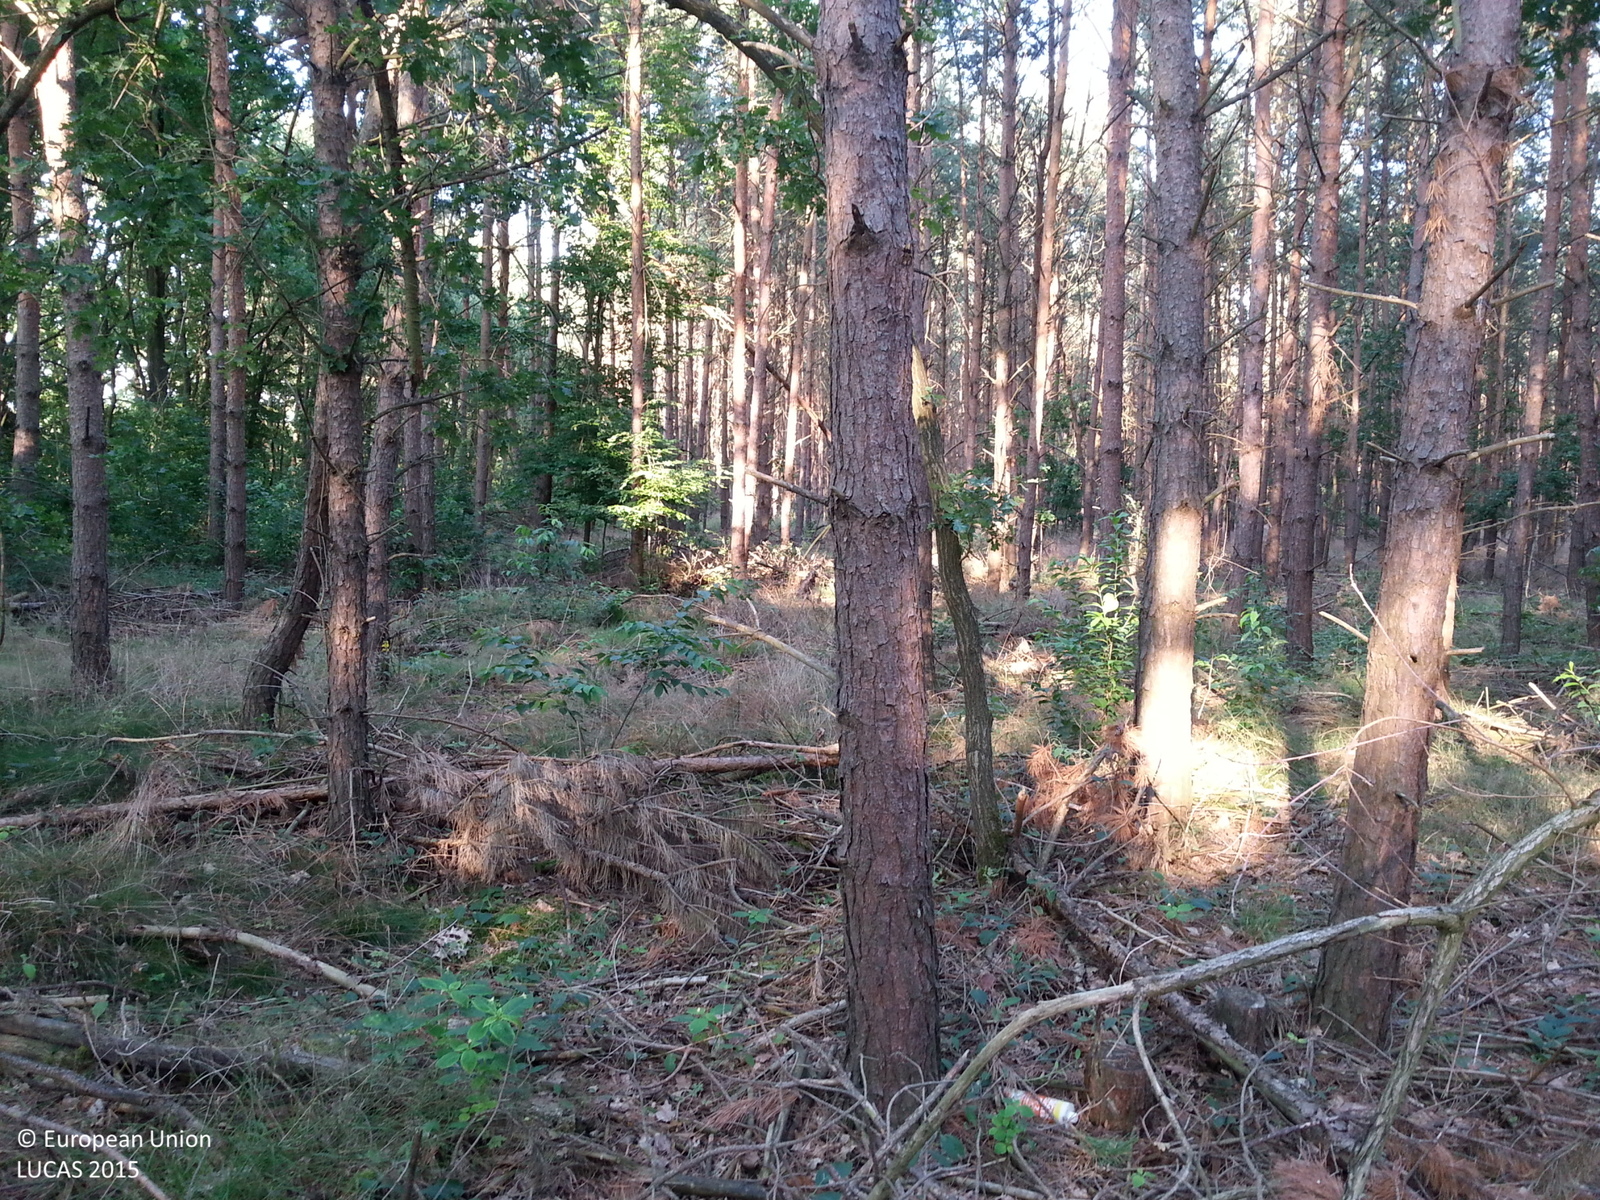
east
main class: Woodland
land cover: Pine dominated coniferous woodland
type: hemiboreal forest and nemoral coniferous forest and mixed broadleaved-coniferous forest
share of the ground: 50 - 75 %
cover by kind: coniferous forest trees 55 %, lichens and mosses 15 %, unconsolidated bare surface 15 %, herbaceous plants 10 %, shrubs 5 %
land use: Forestry
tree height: > 5 m
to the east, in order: Pine dominated coniferous woodland
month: July
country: DE
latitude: 53.0298
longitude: 11.7440
